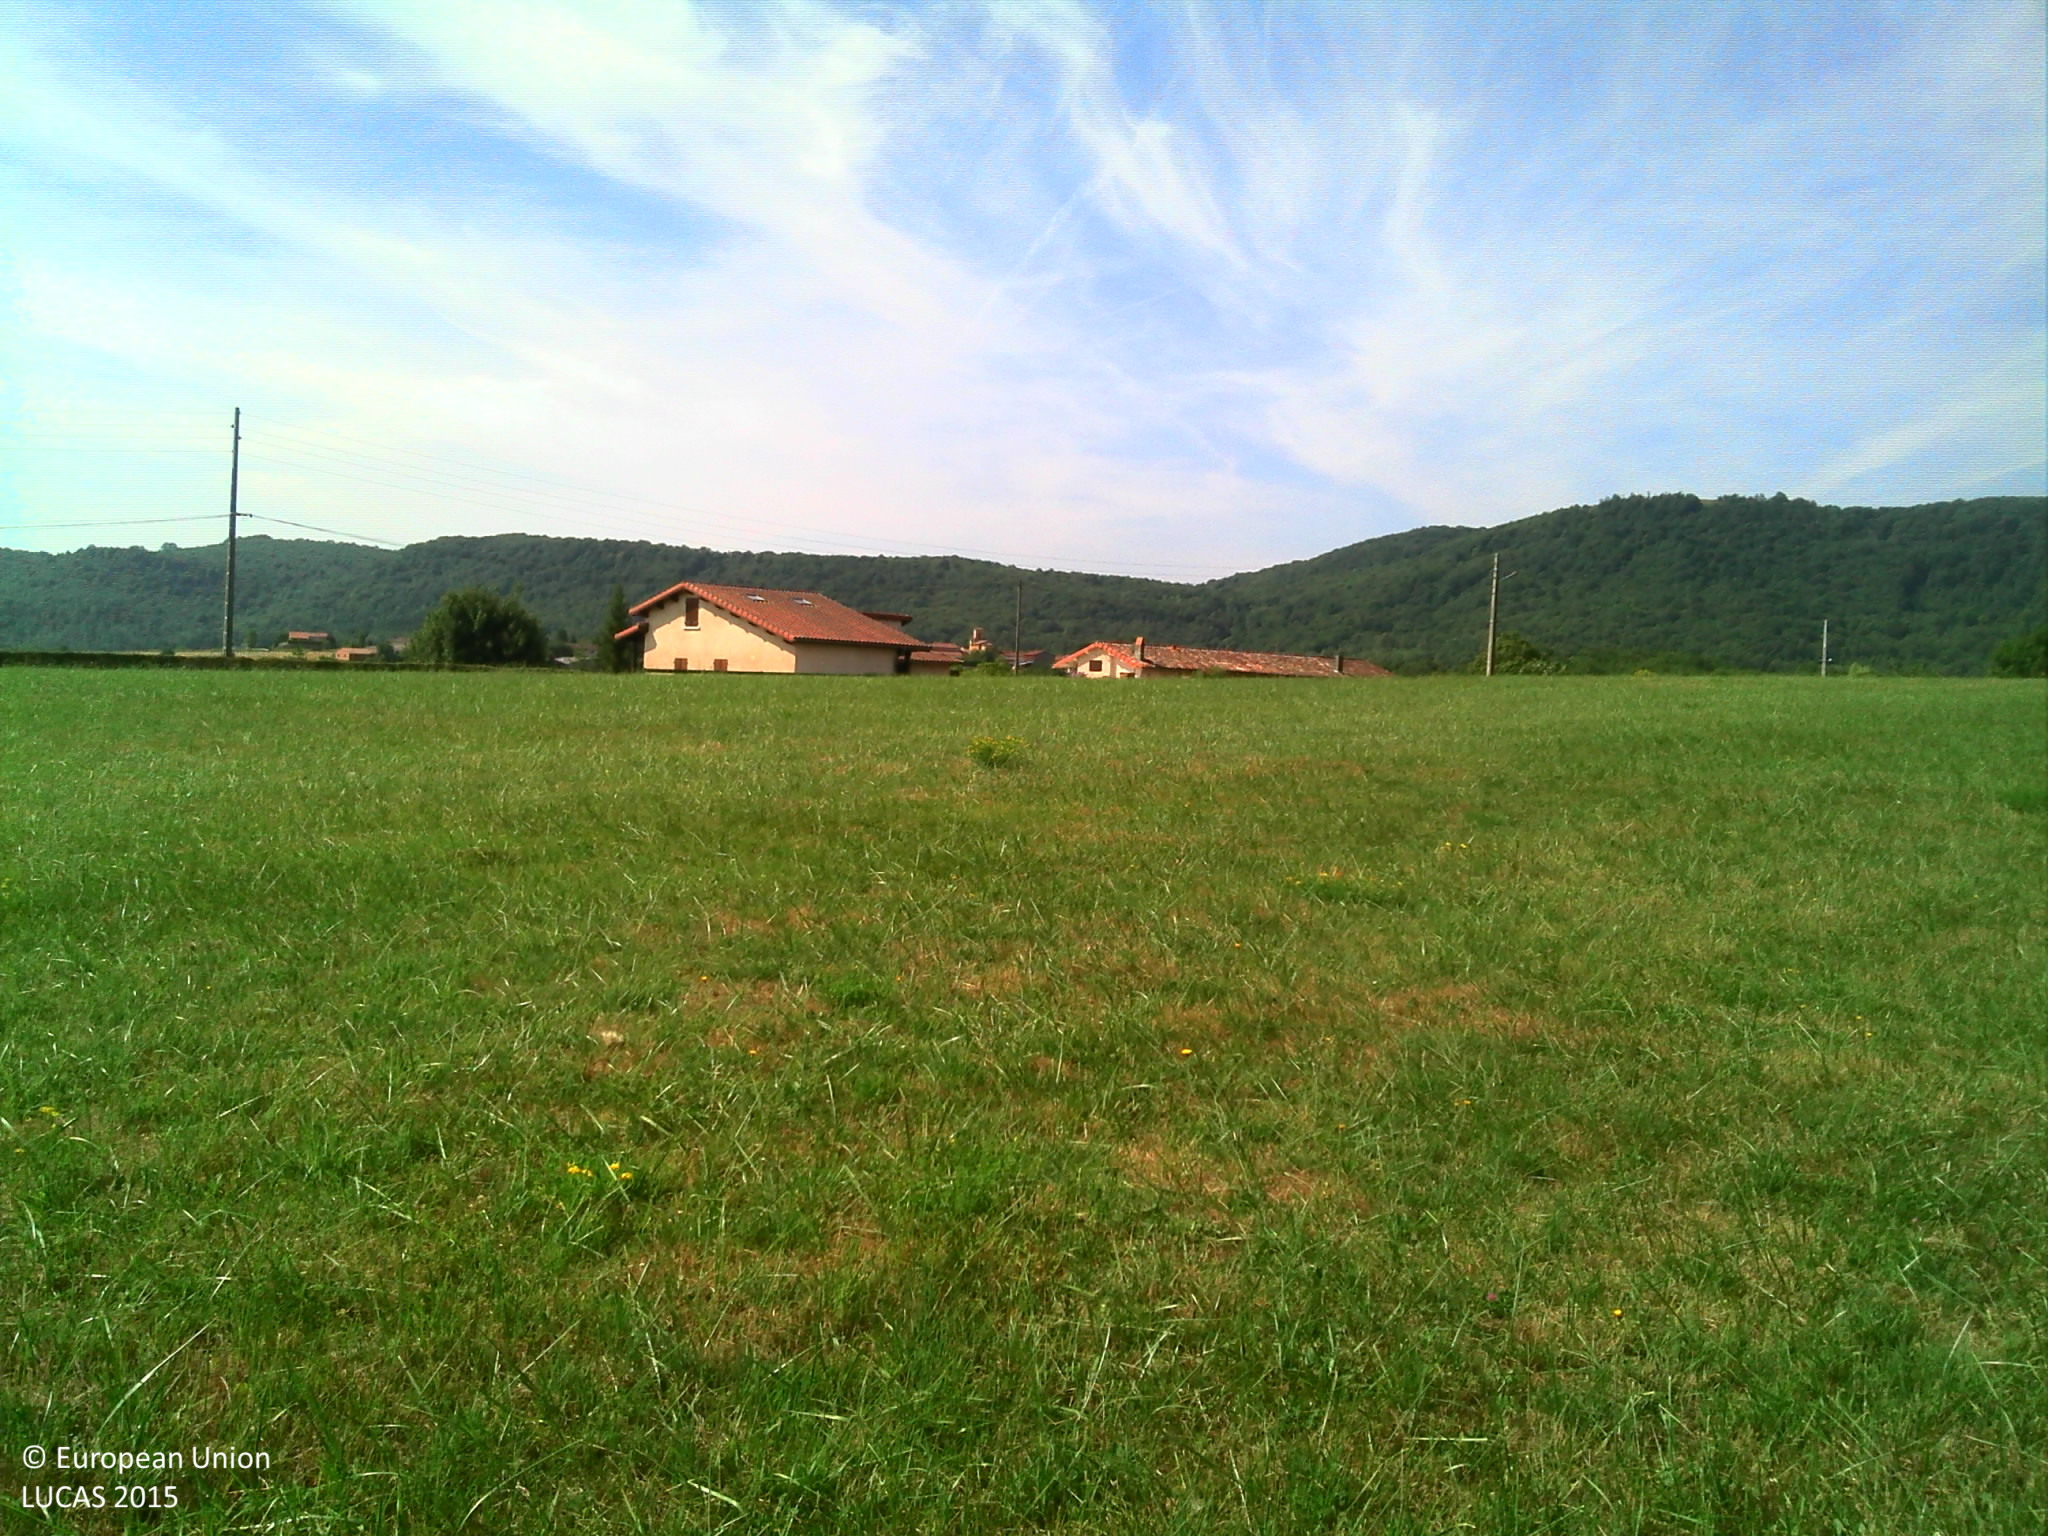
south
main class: Grassland
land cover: Grassland without tree/shrub cover
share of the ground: > 75 %
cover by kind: herbaceous plants 100 %
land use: Agriculture (excluding fallow land and kitchen gardens)
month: July
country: FR
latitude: 43.1658
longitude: 1.0613
